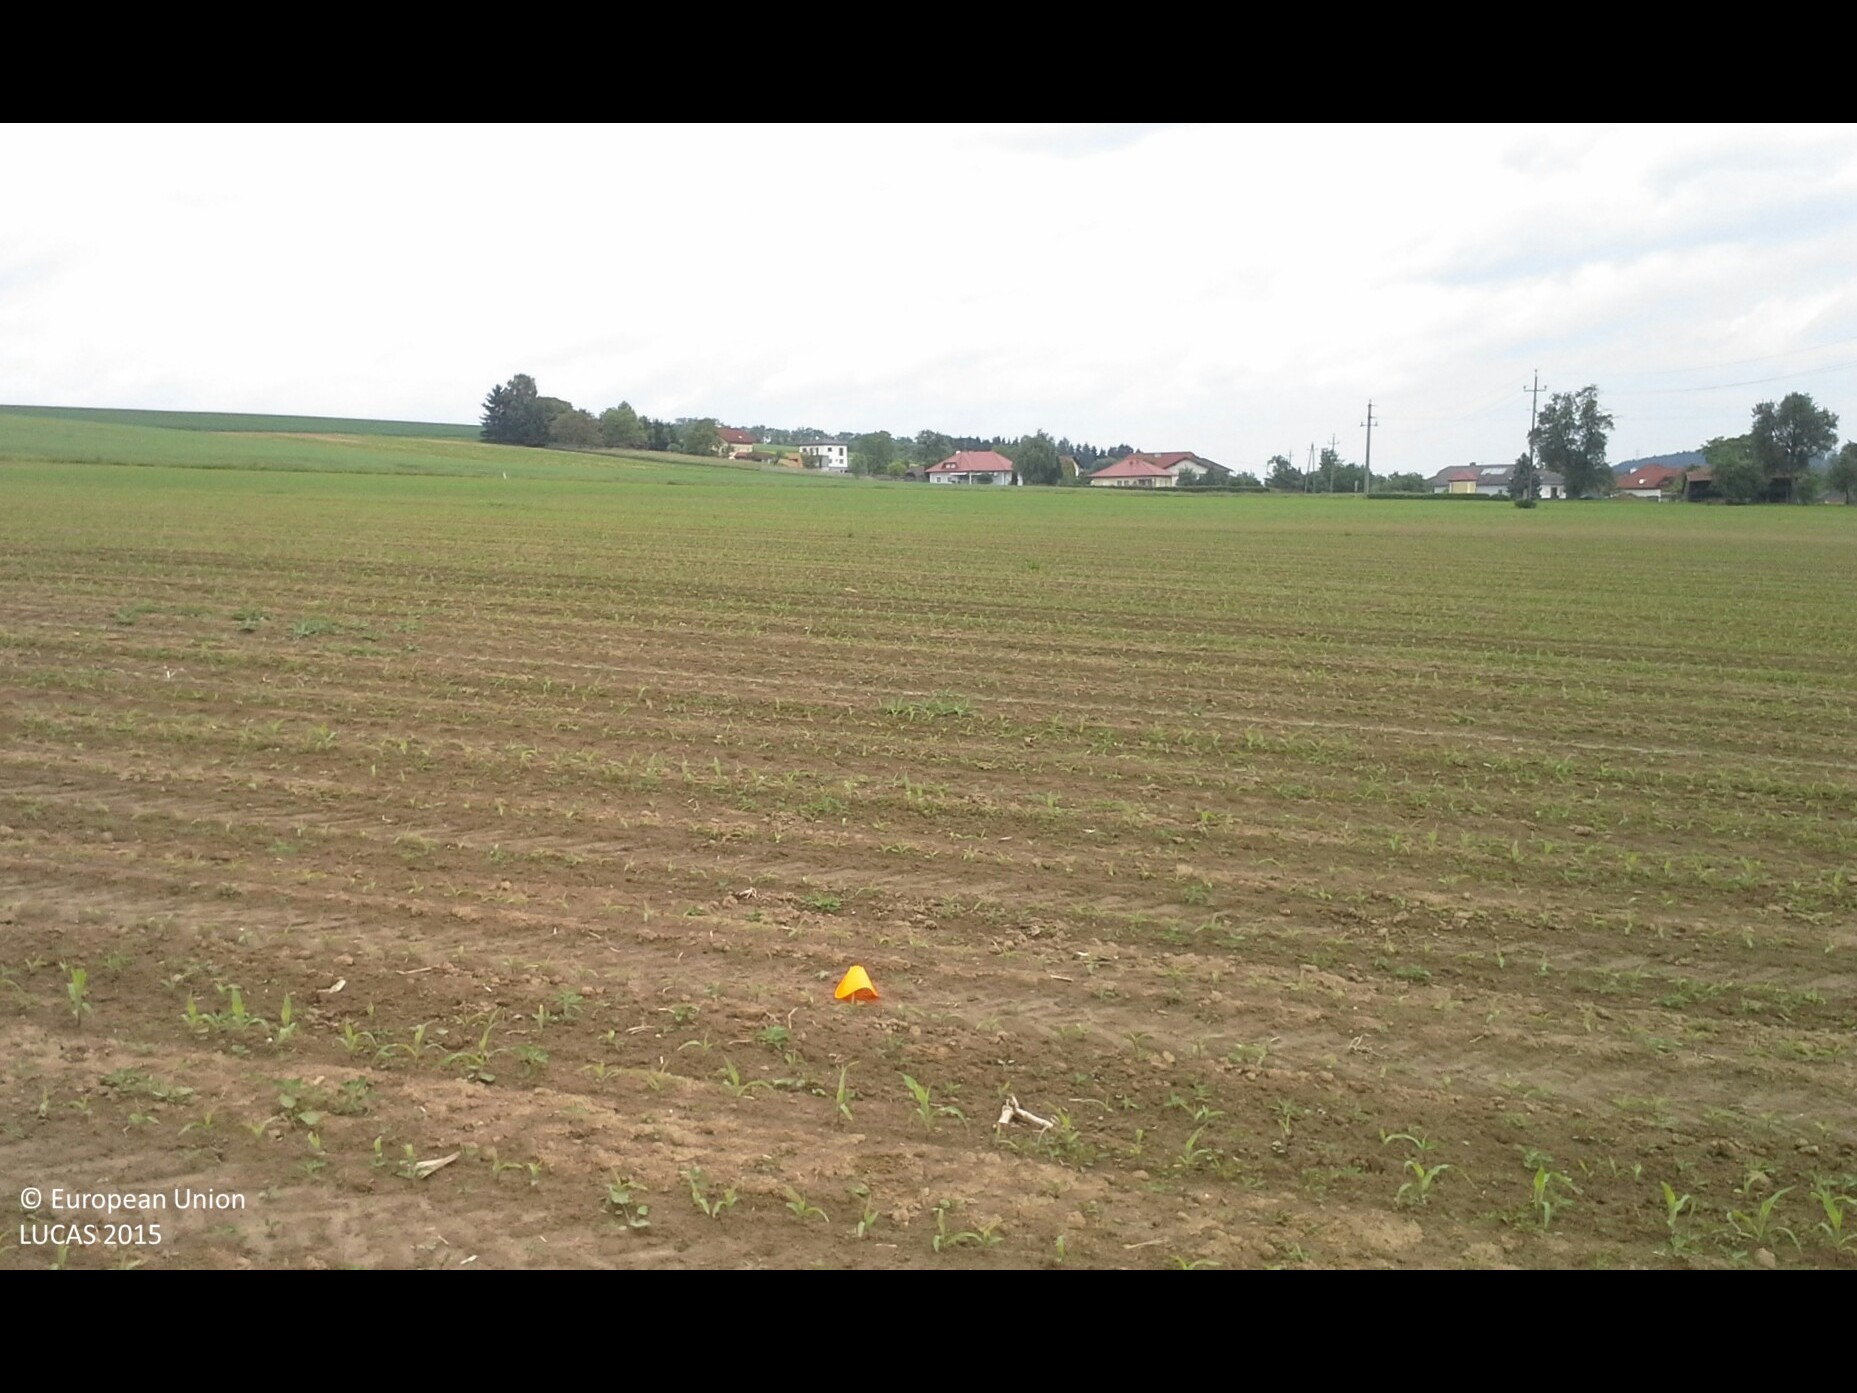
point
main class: Cropland
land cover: Maize
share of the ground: < 10 %
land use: Agriculture (excluding fallow land and kitchen gardens)
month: May
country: AT
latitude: 48.1529
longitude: 14.4226
